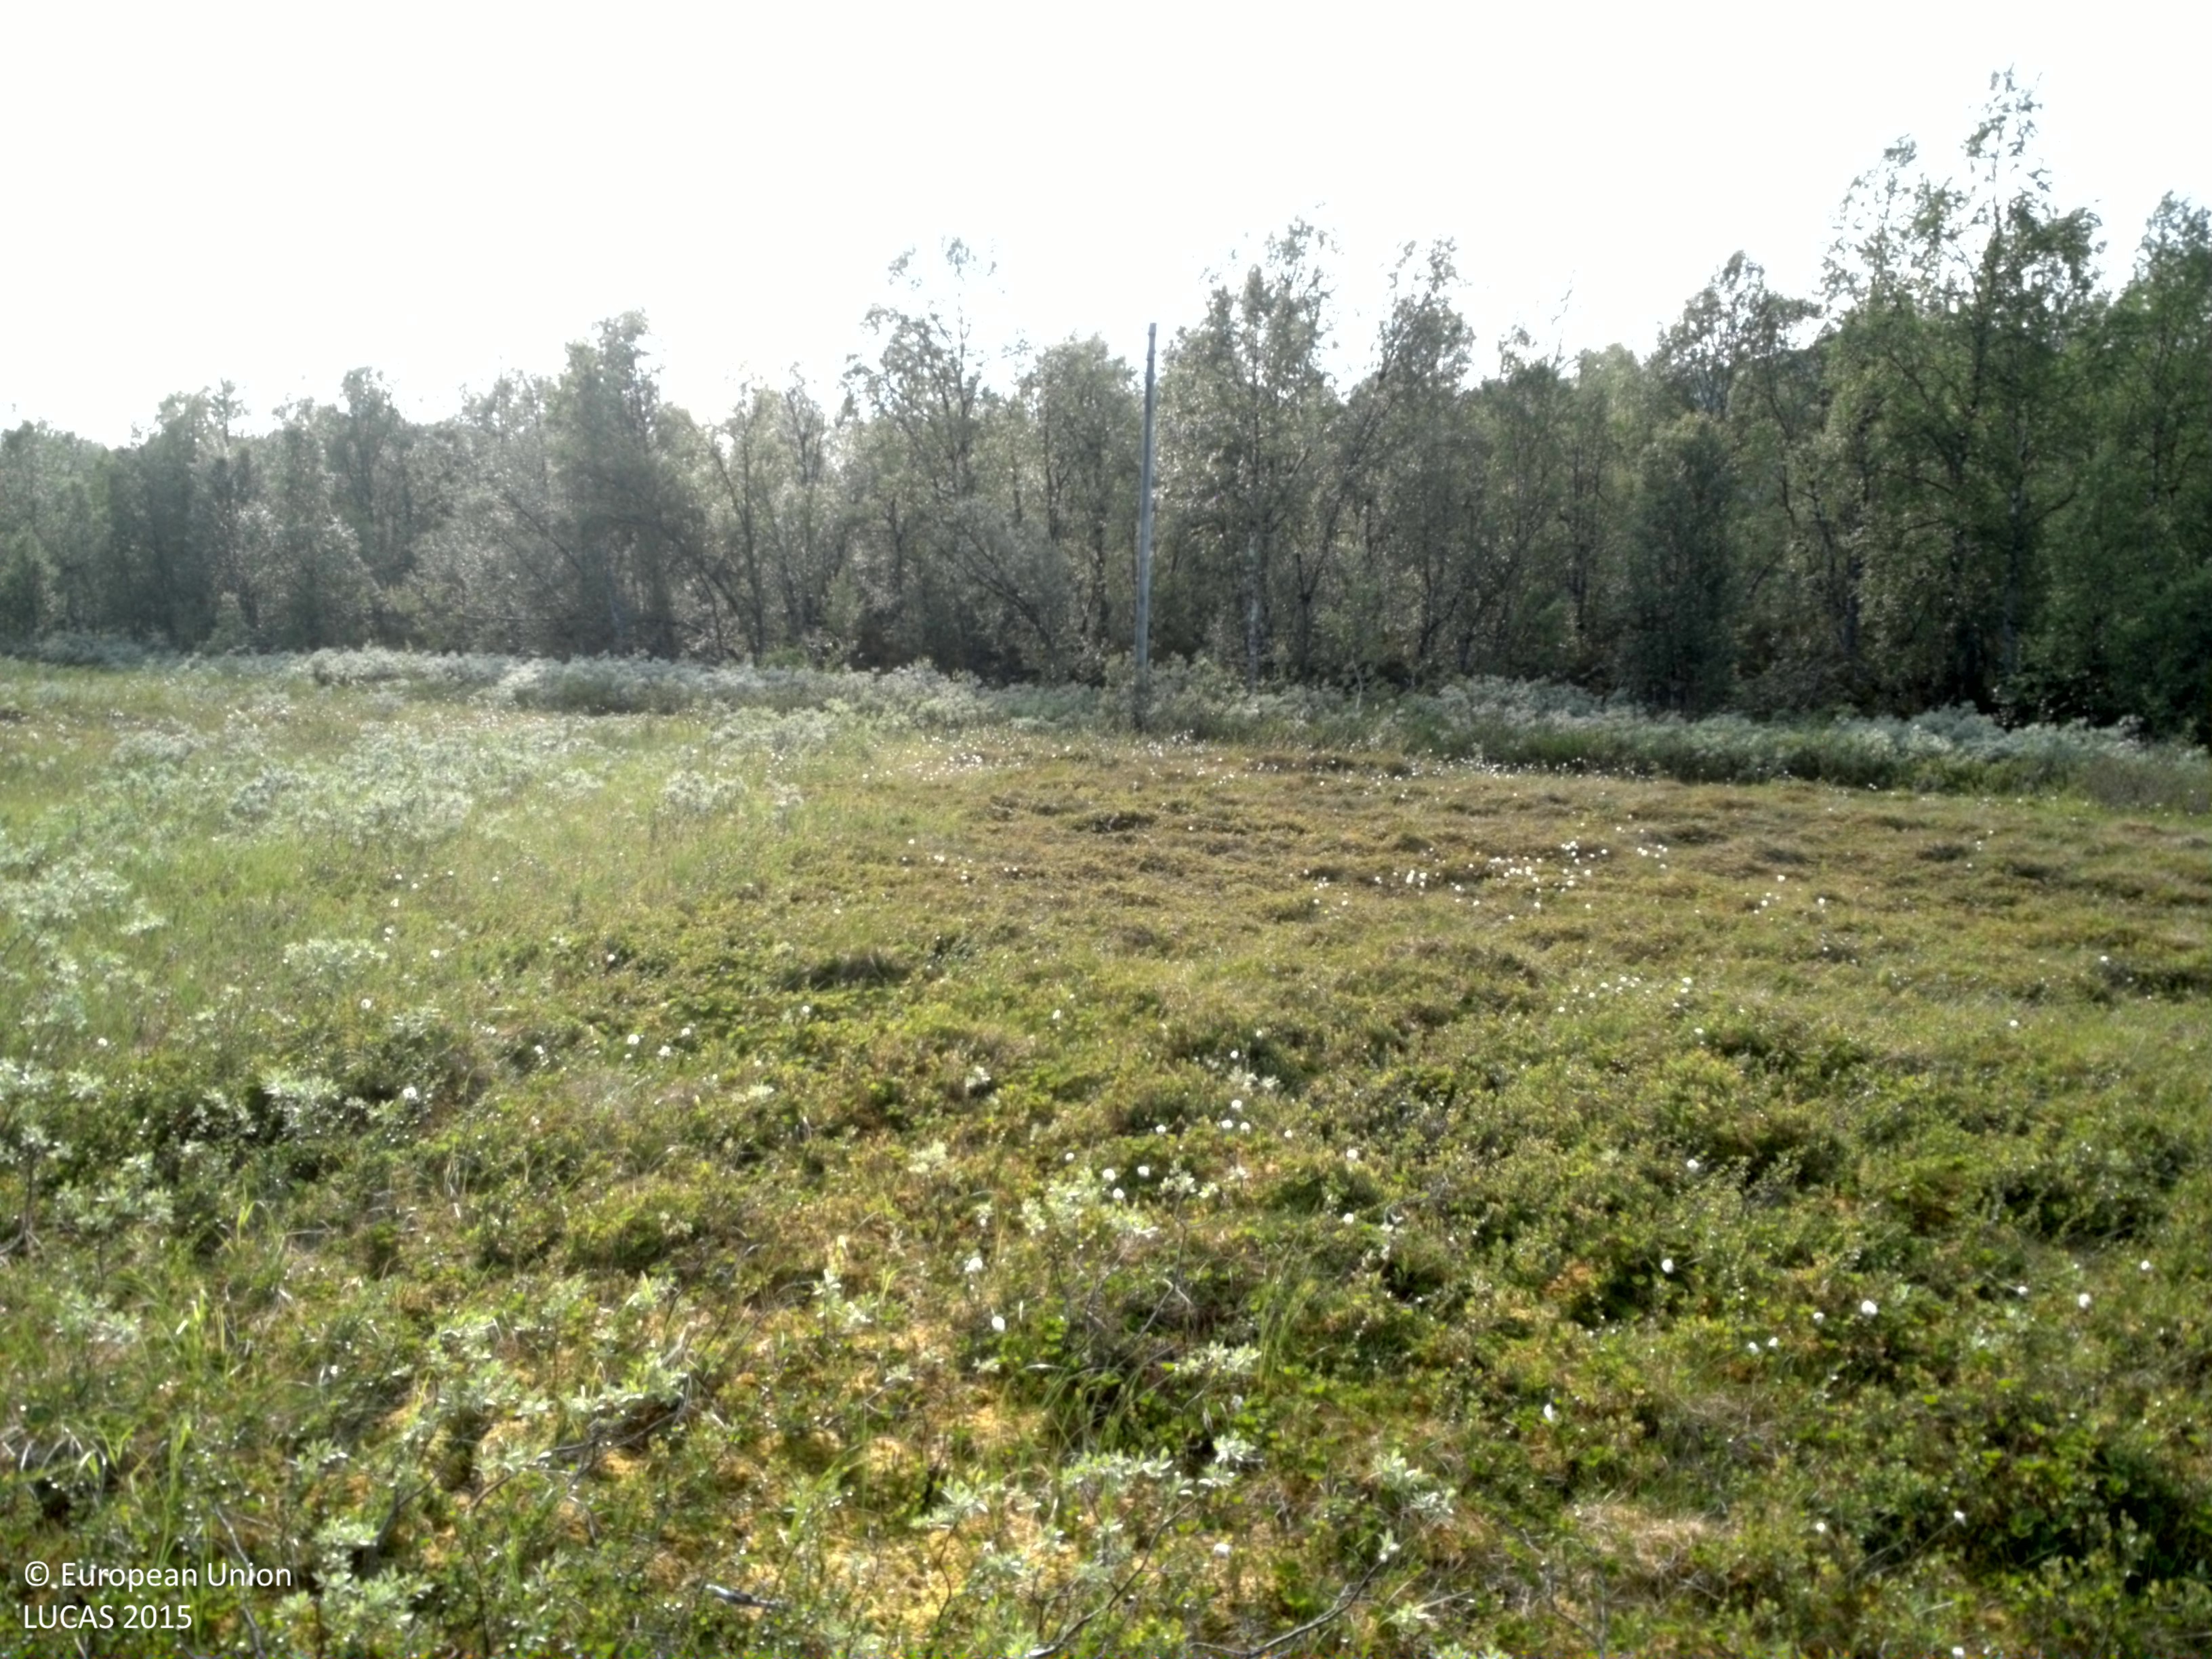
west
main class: Shrubland
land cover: Shrubland without tree cover
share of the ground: 25 - 50 %
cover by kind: herbaceous plants 55 %, shrubs 25 %, lichens and mosses 20 %
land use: Semi-natural and natural areas not in use
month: July
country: SE
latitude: 65.7540
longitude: 15.4411
